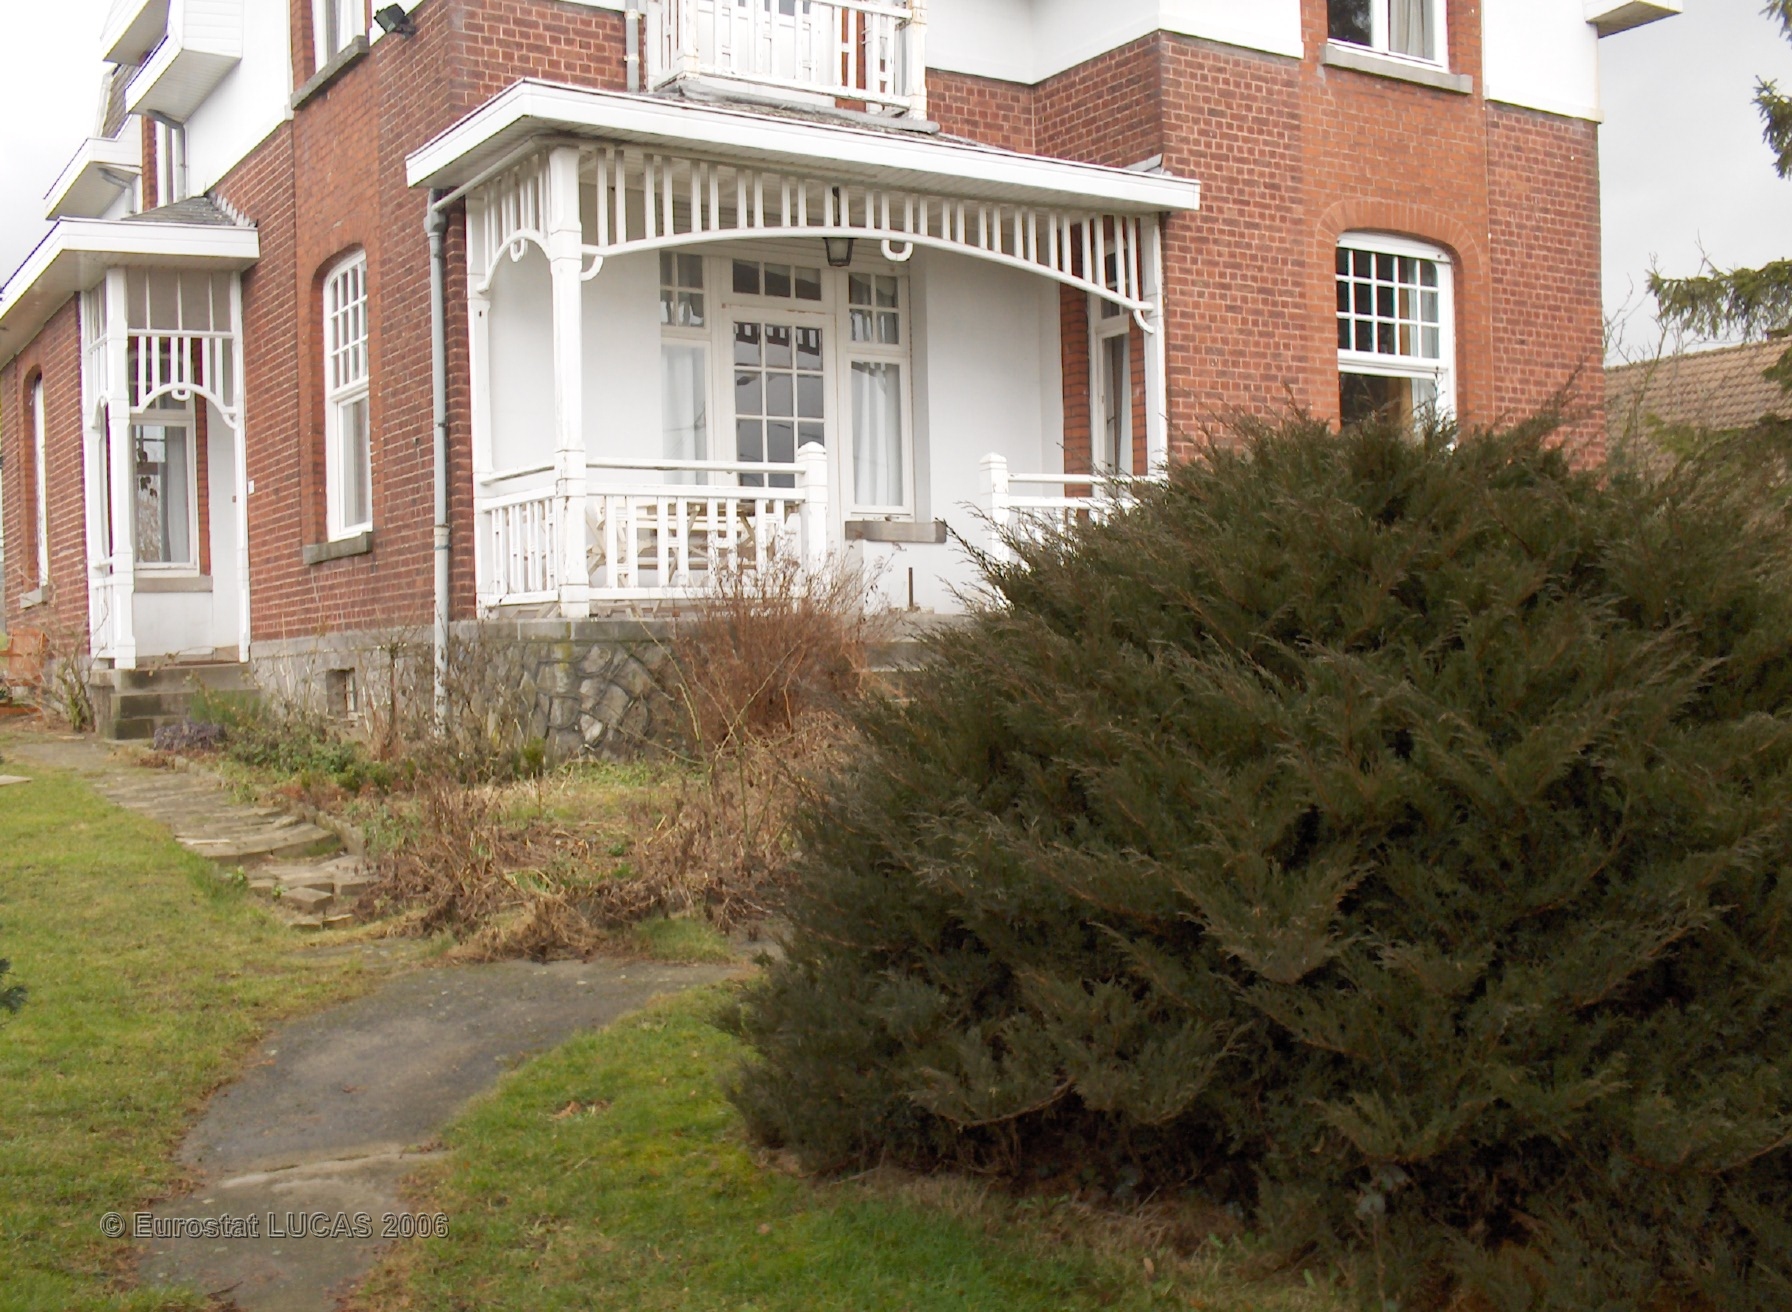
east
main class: Grassland
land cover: Grassland with sparse tree/shrub cover
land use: Residential
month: February
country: BE
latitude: 50.7742
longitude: 4.5363
